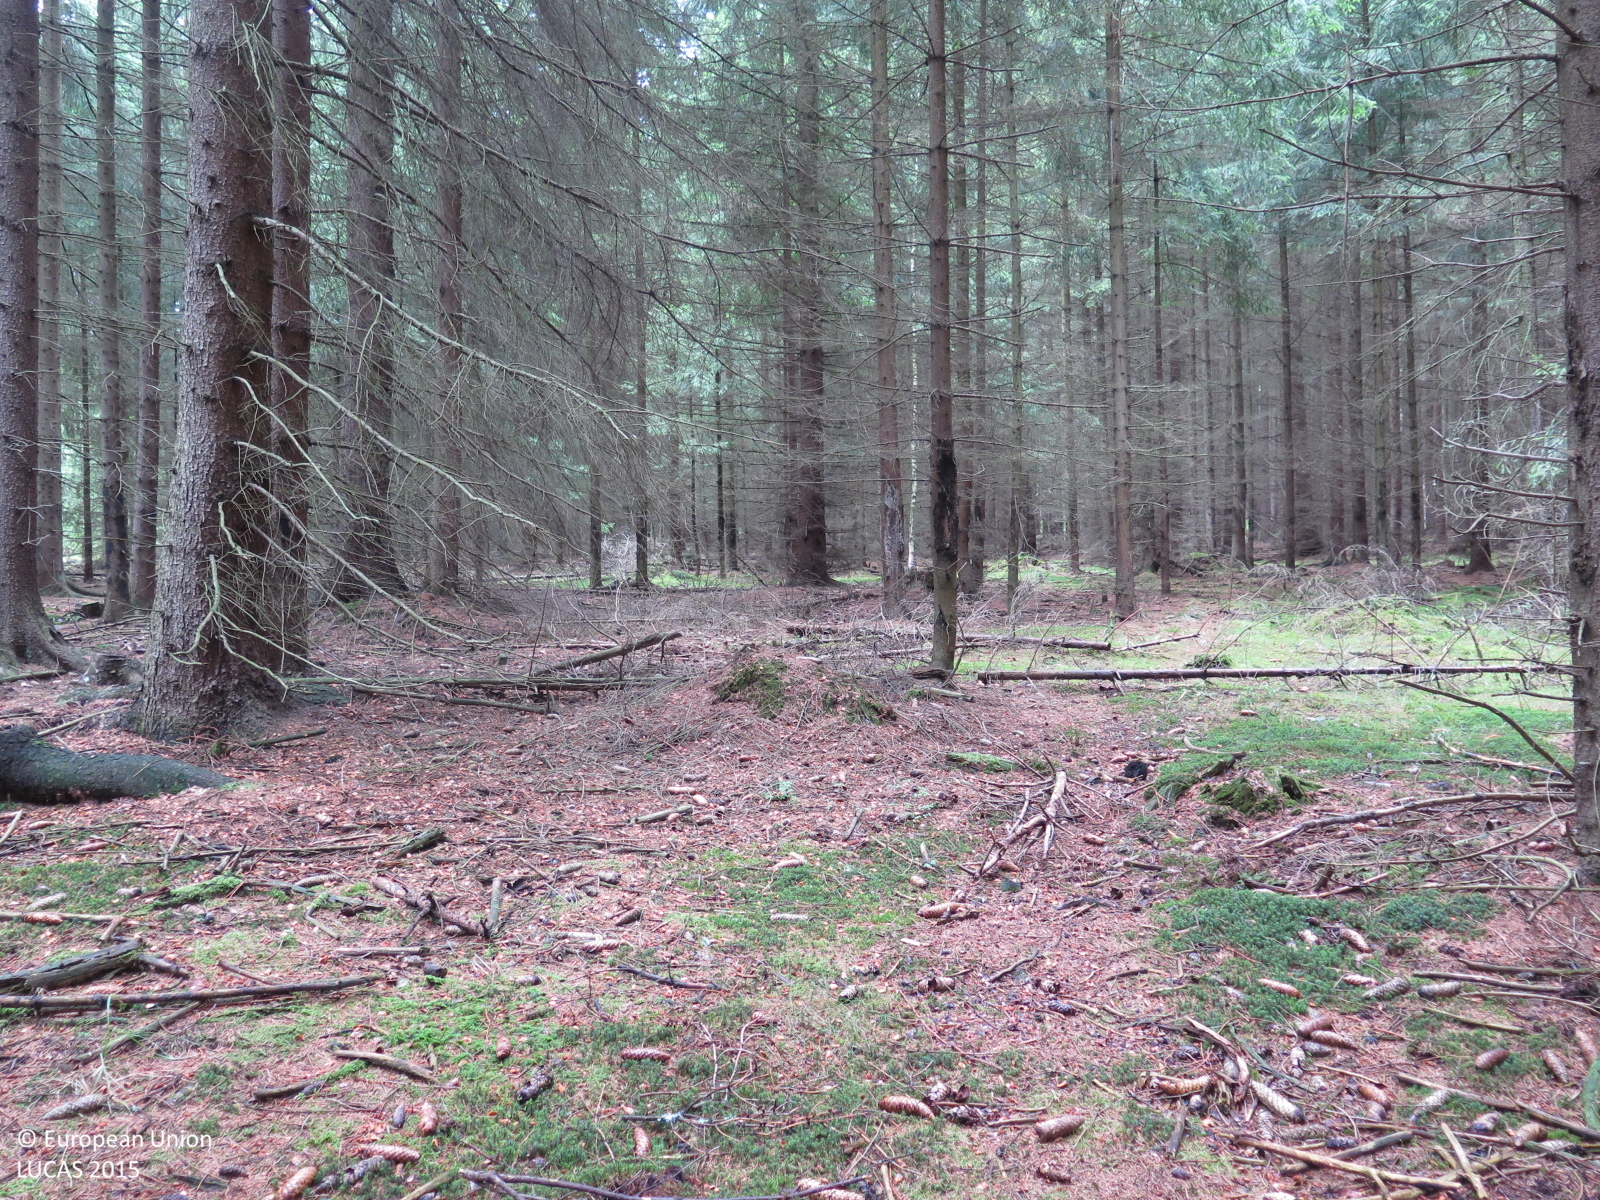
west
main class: Woodland
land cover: Spruce dominated coniferous woodland
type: hemiboreal forest and nemoral coniferous forest and mixed broadleaved-coniferous forest
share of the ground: > 75 %
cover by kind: coniferous forest trees 95 %, lichens and mosses 5 %
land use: Forestry
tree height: > 5 m
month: August
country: CZ
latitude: 49.7603
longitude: 13.8181
